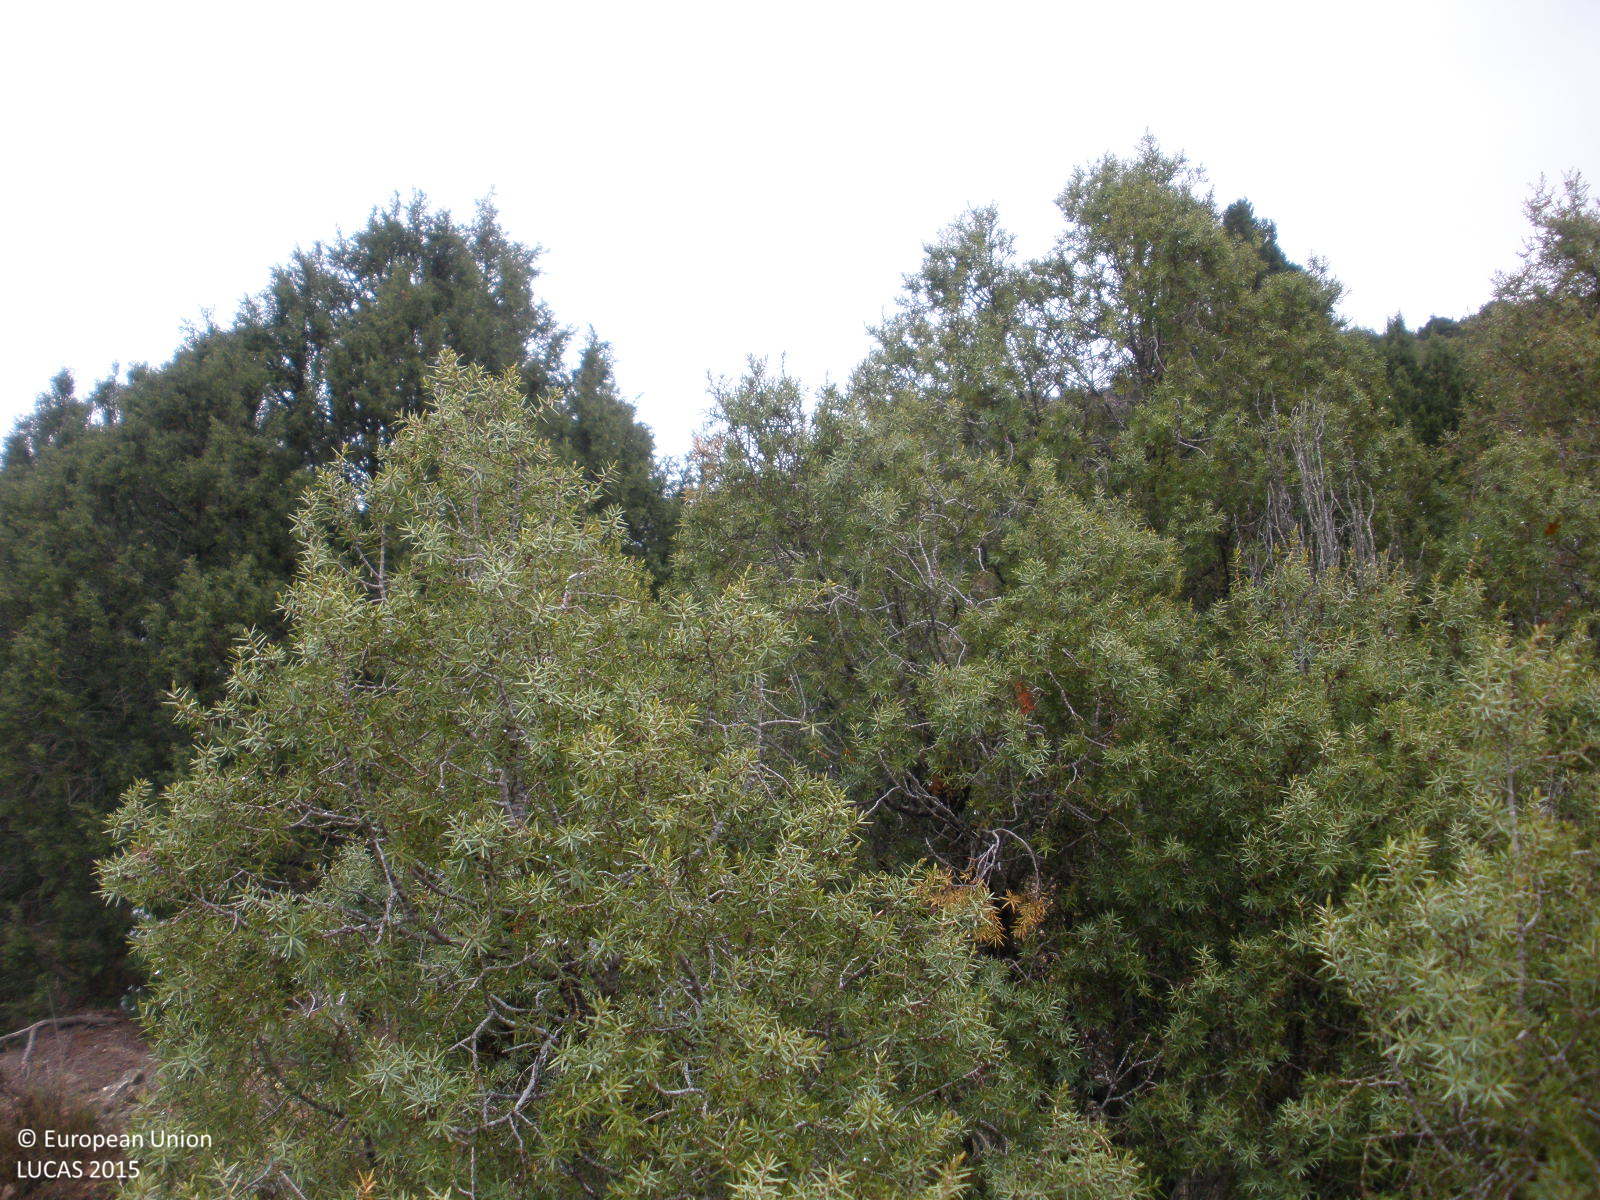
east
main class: Shrubland
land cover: Shrubland without tree cover
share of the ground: 50 - 75 %
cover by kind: shrubs 60 %, consolidated bare surface 30 %, herbaceous plants 10 %
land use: Agriculture (excluding fallow land and kitchen gardens)
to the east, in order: Shrubland without tree cover; Other coniferous woodland
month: April
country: ES
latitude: 40.2429
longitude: -1.2128
